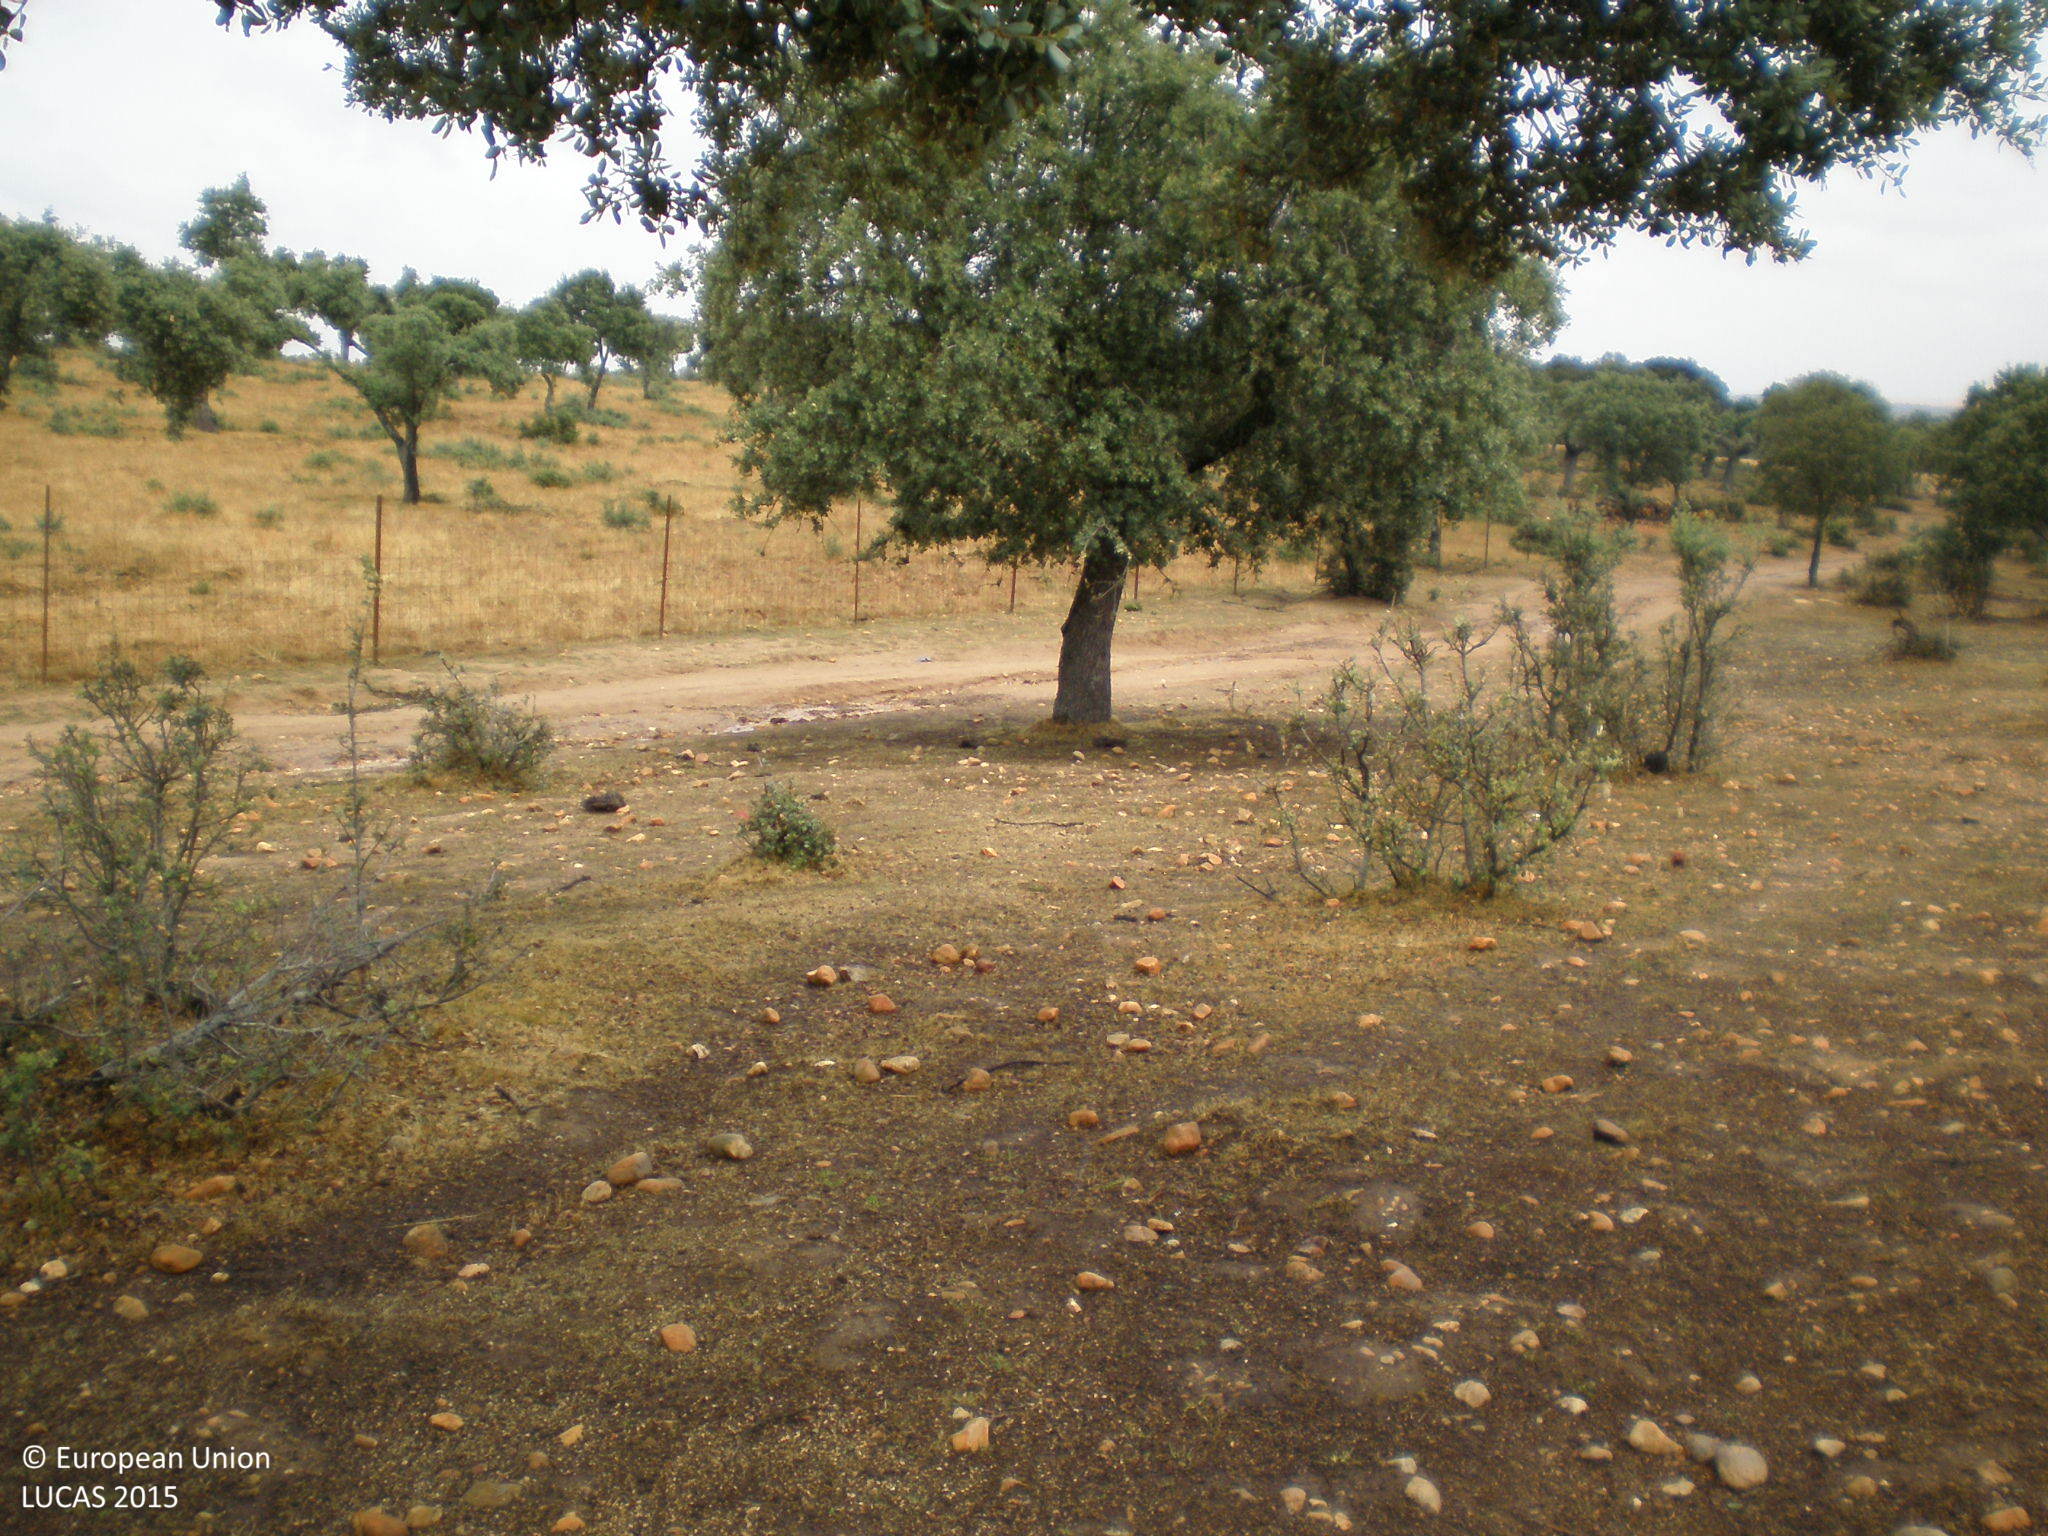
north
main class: Woodland
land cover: Broadleaved woodland
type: broadleaved evergreen forest
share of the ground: 25 - 50 %
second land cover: Grassland without tree/shrub cover
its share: 50 - 75 %
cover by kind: herbaceous plants 70 %, broadleaved forest trees 30 %
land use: Forestry
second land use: Agriculture (excluding fallow land and kitchen gardens)
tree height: > 5 m
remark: Clear cut
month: June
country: ES
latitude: 41.0066
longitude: -5.7623
